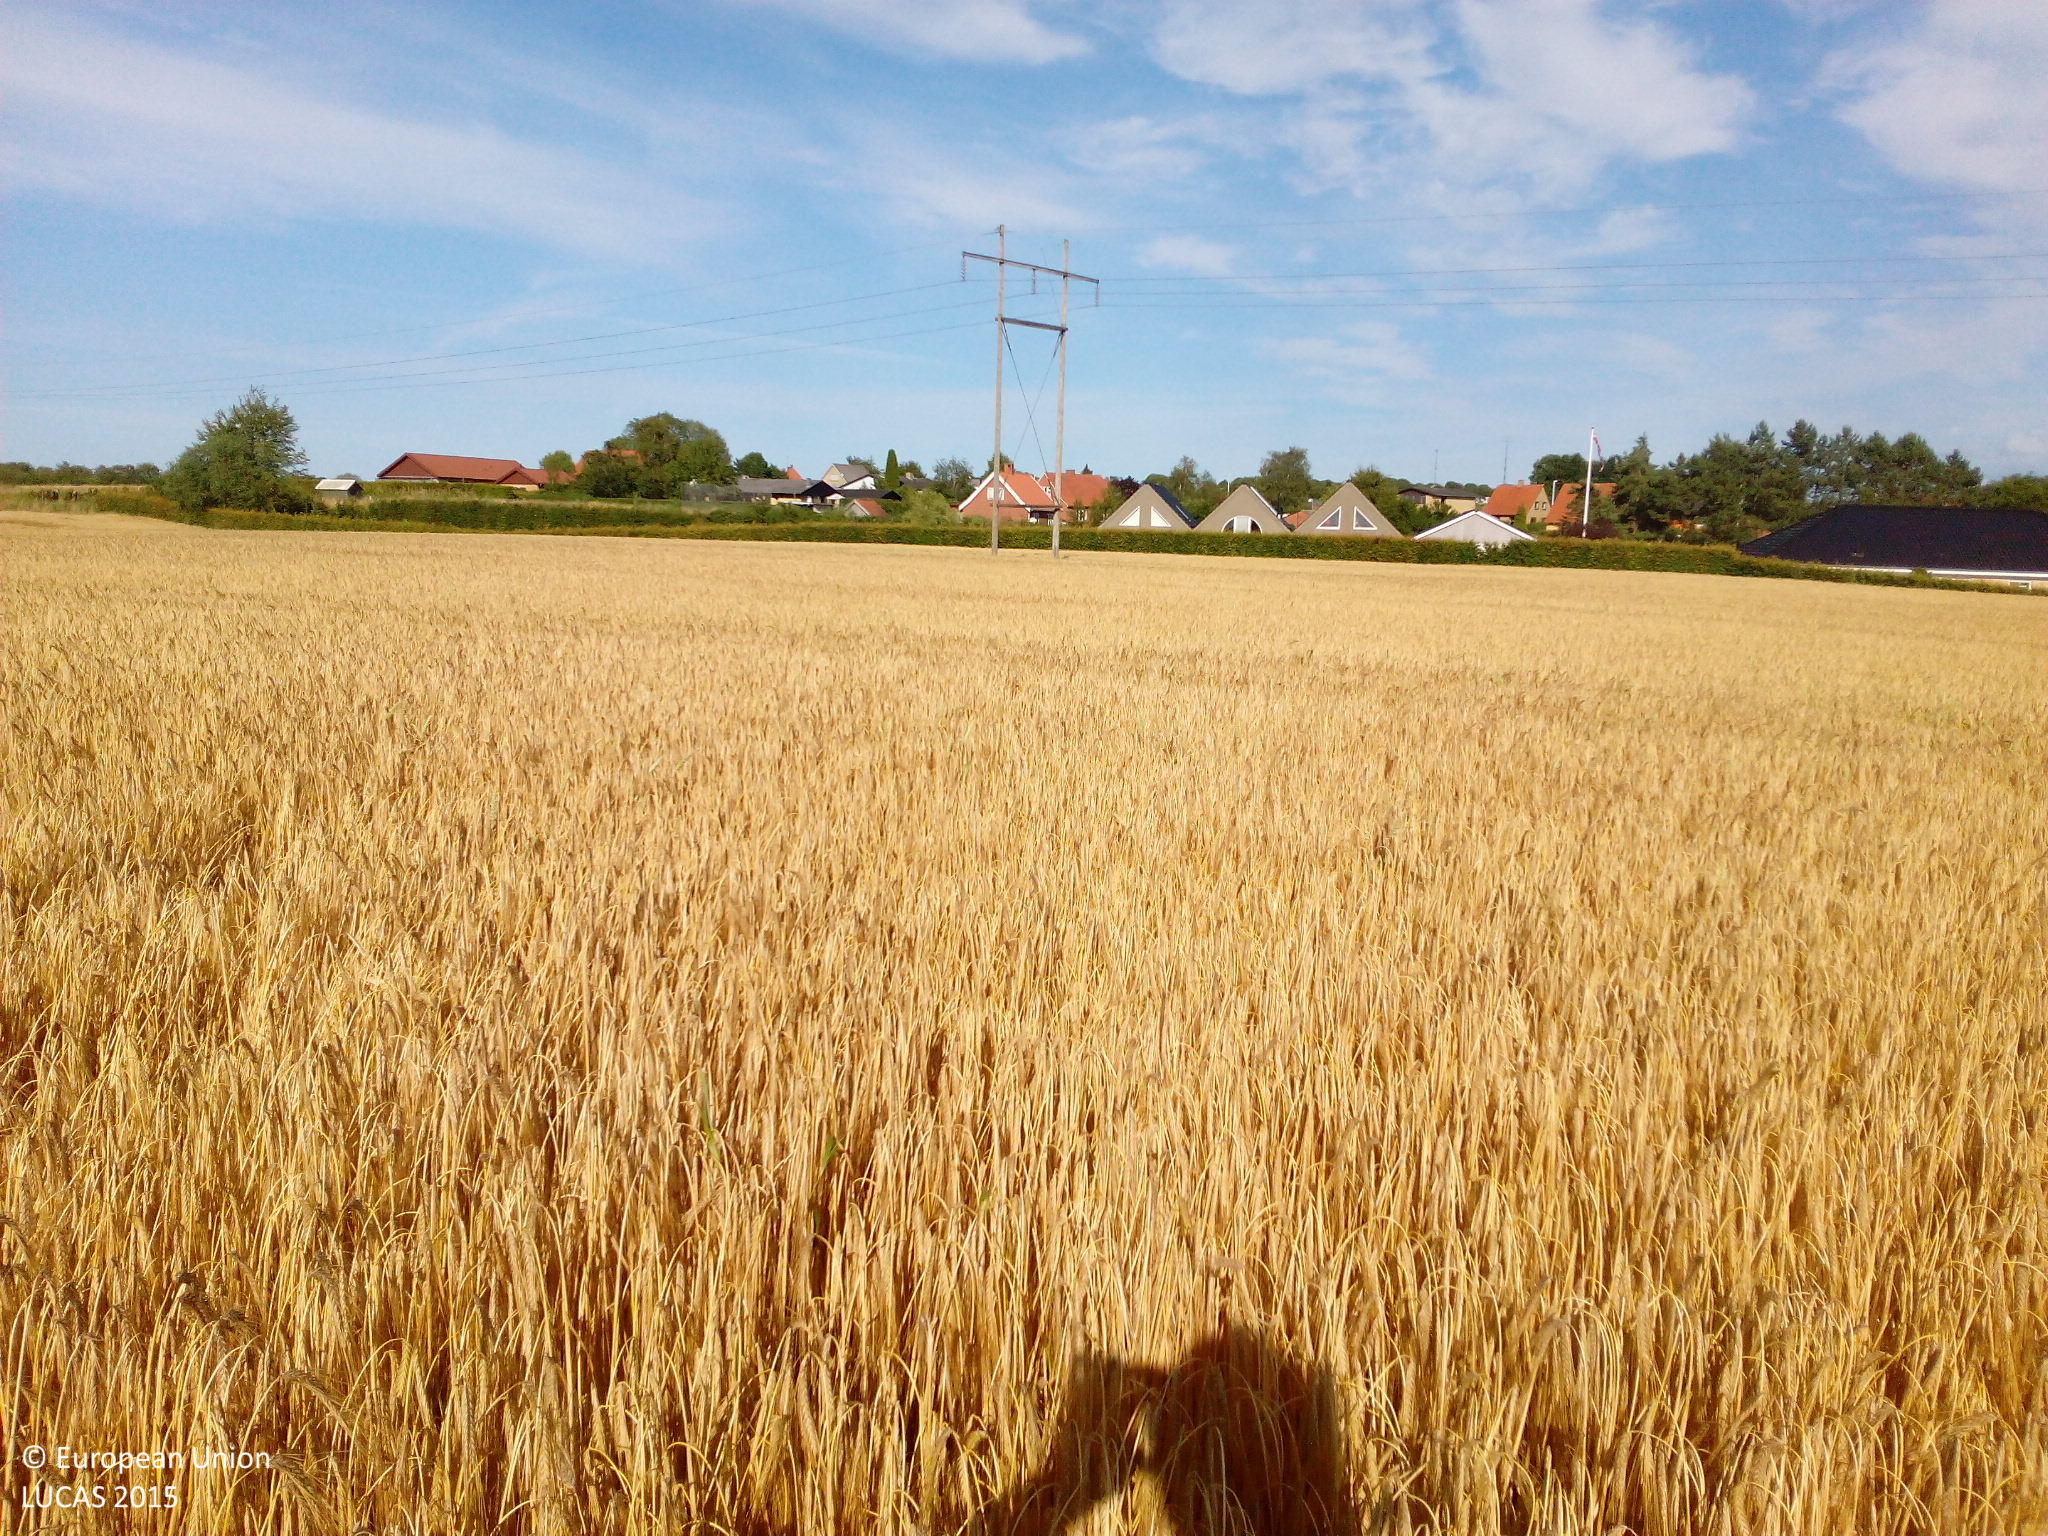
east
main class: Cropland
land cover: Barley
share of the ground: > 75 %
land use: Agriculture (excluding fallow land and kitchen gardens)
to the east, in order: Barley; Electric lines; Barley; Artificial constructions in urban areas
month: July
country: DK
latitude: 55.6555
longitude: 11.6673
